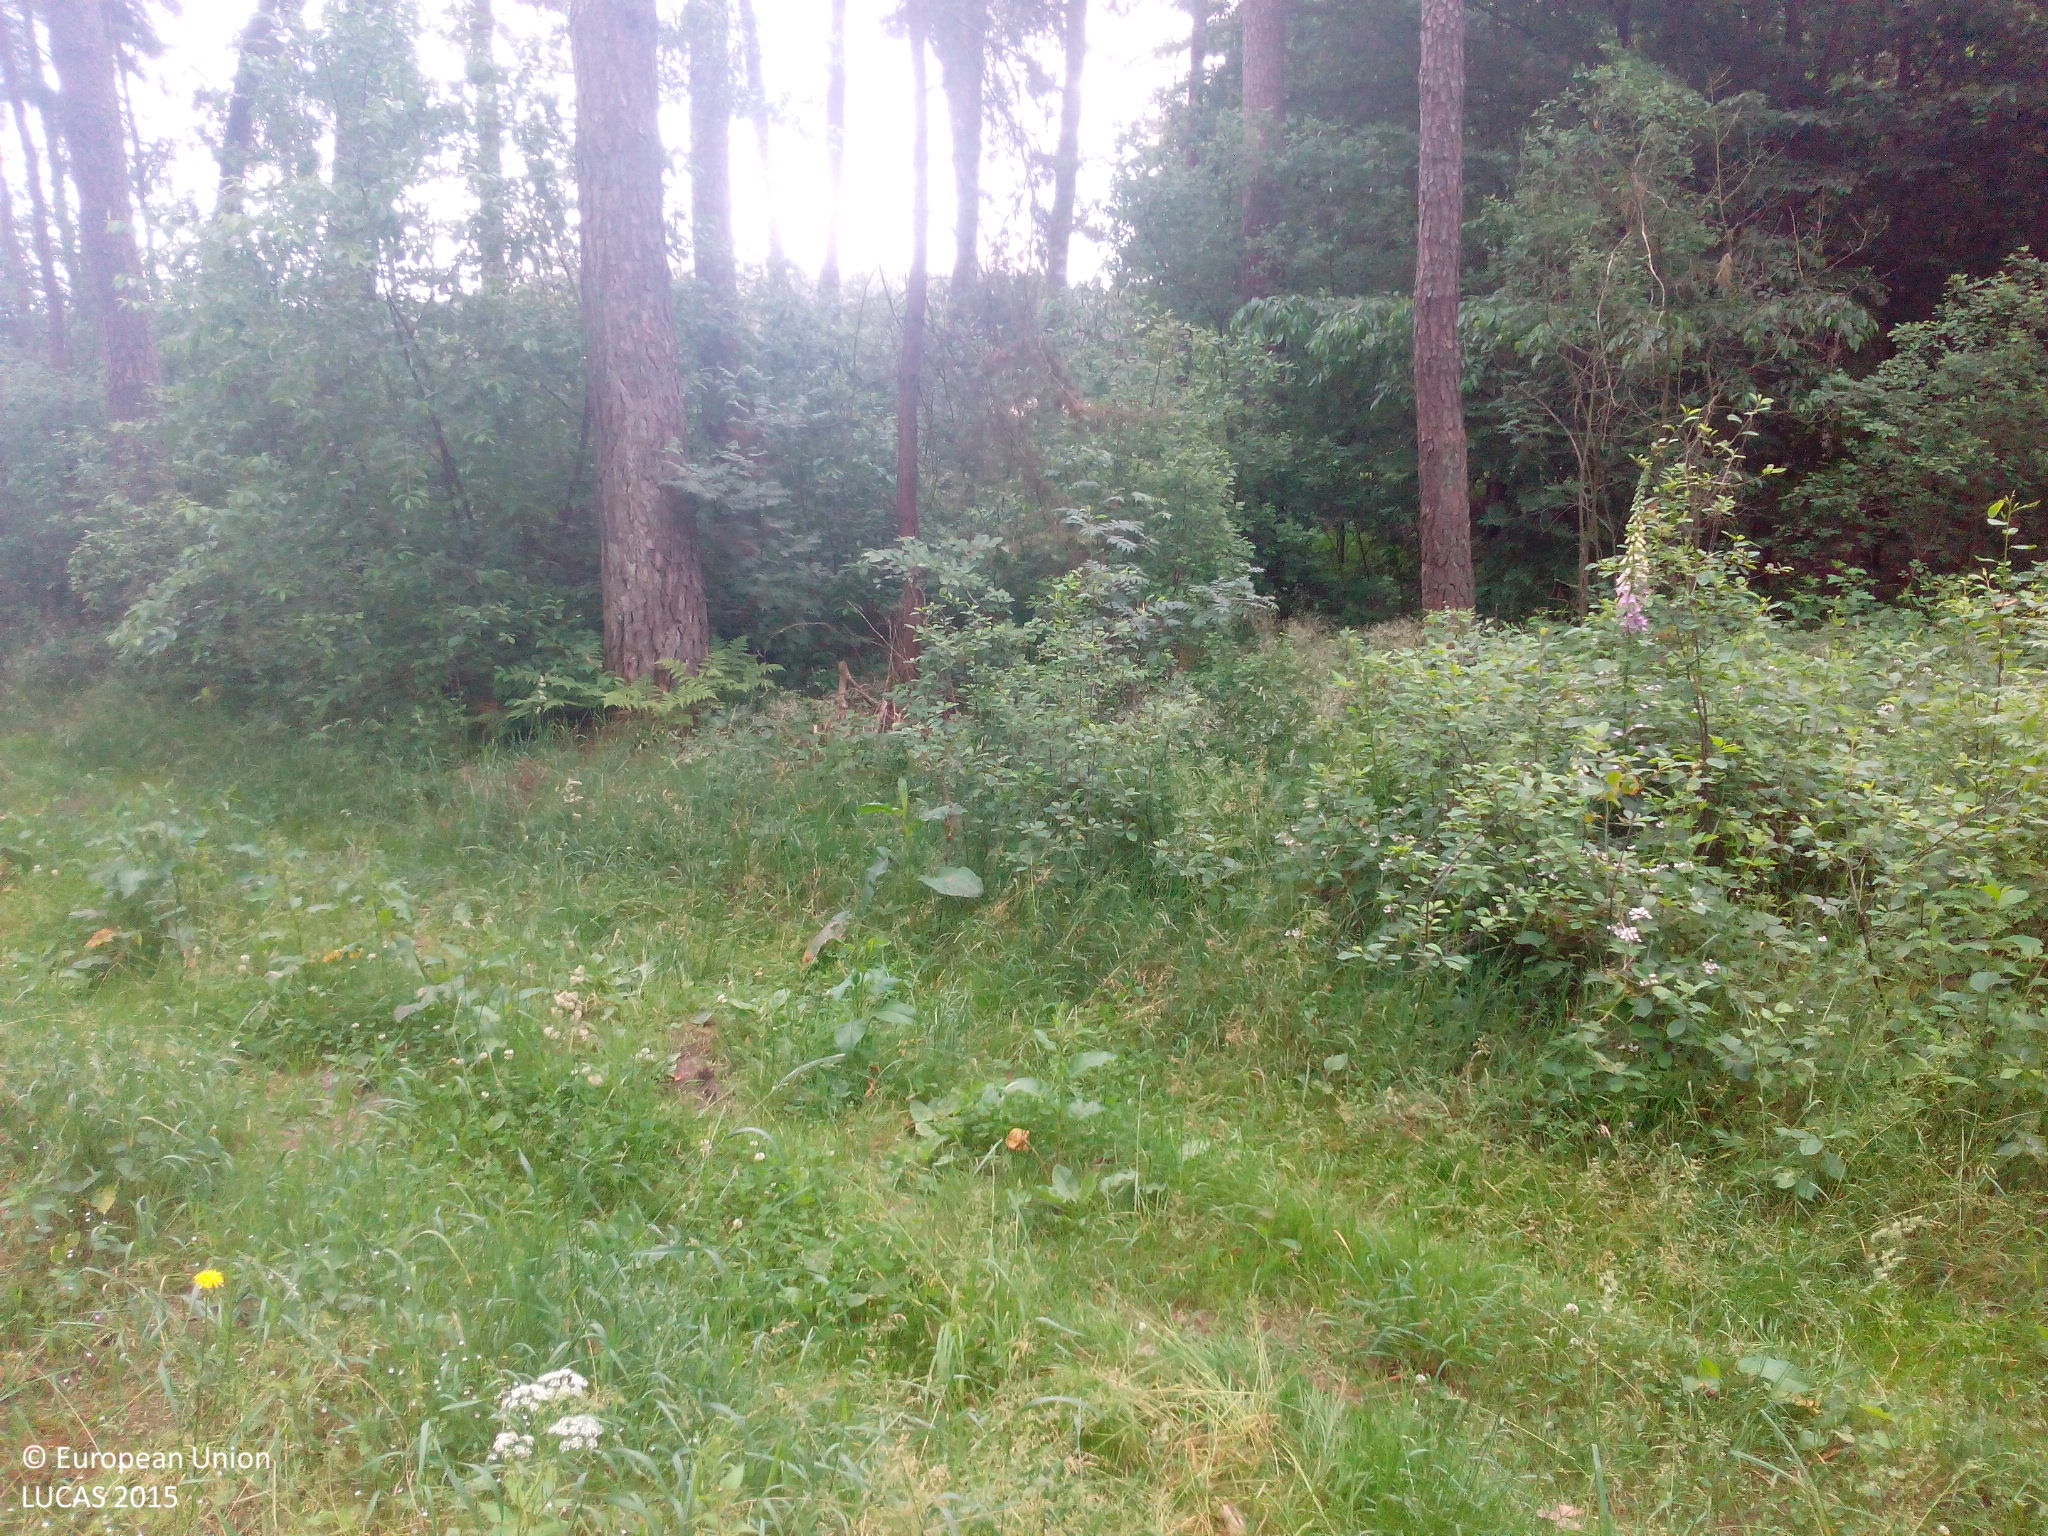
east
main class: Woodland
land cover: Pine dominated coniferous woodland
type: hemiboreal forest and nemoral coniferous forest and mixed broadleaved-coniferous forest
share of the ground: 50 - 75 %
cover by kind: coniferous forest trees 70 %, herbaceous plants 20 %, shrubs 10 %
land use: Forestry
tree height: > 5 m
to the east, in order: Pine dominated coniferous woodland; Tracks; Pine dominated coniferous woodland; Grass margins; Tracks; Grassland without tree/shrub cover; Ditches and canals; Grassland without tree/shrub cover; Temporary grasslands
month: June
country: DE
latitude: 49.2093
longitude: 10.9193
